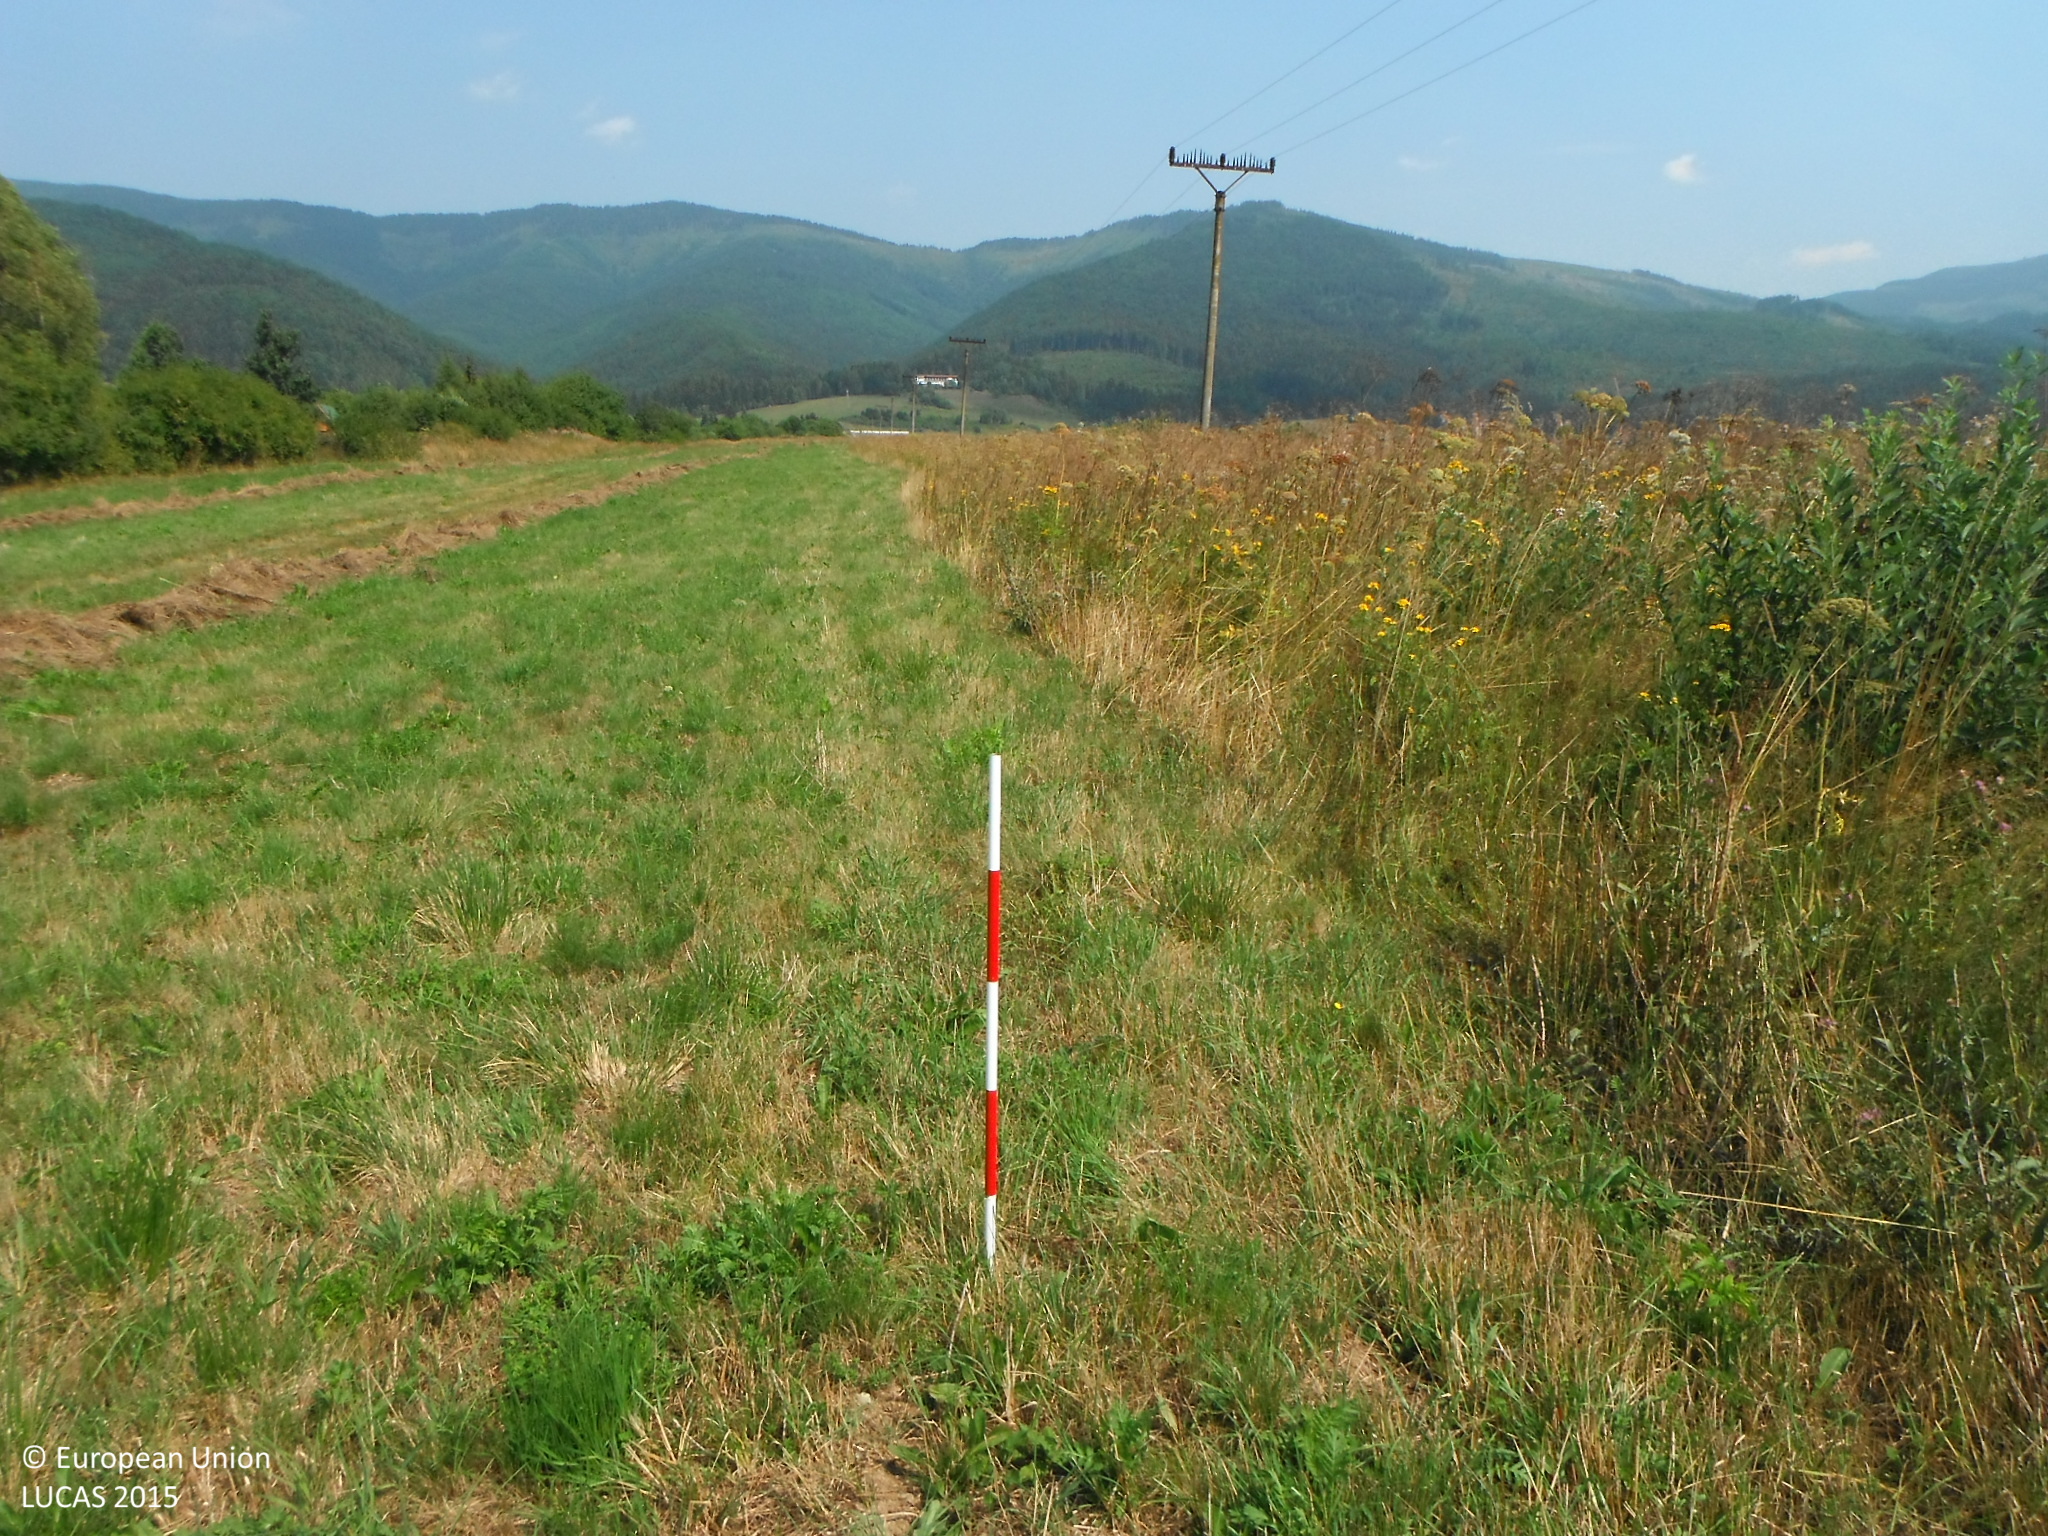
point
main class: Grassland
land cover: Grassland without tree/shrub cover
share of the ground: > 75 %
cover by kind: herbaceous plants 100 %
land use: Agriculture (excluding fallow land and kitchen gardens)
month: August
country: SK
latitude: 48.8633
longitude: 19.9124
